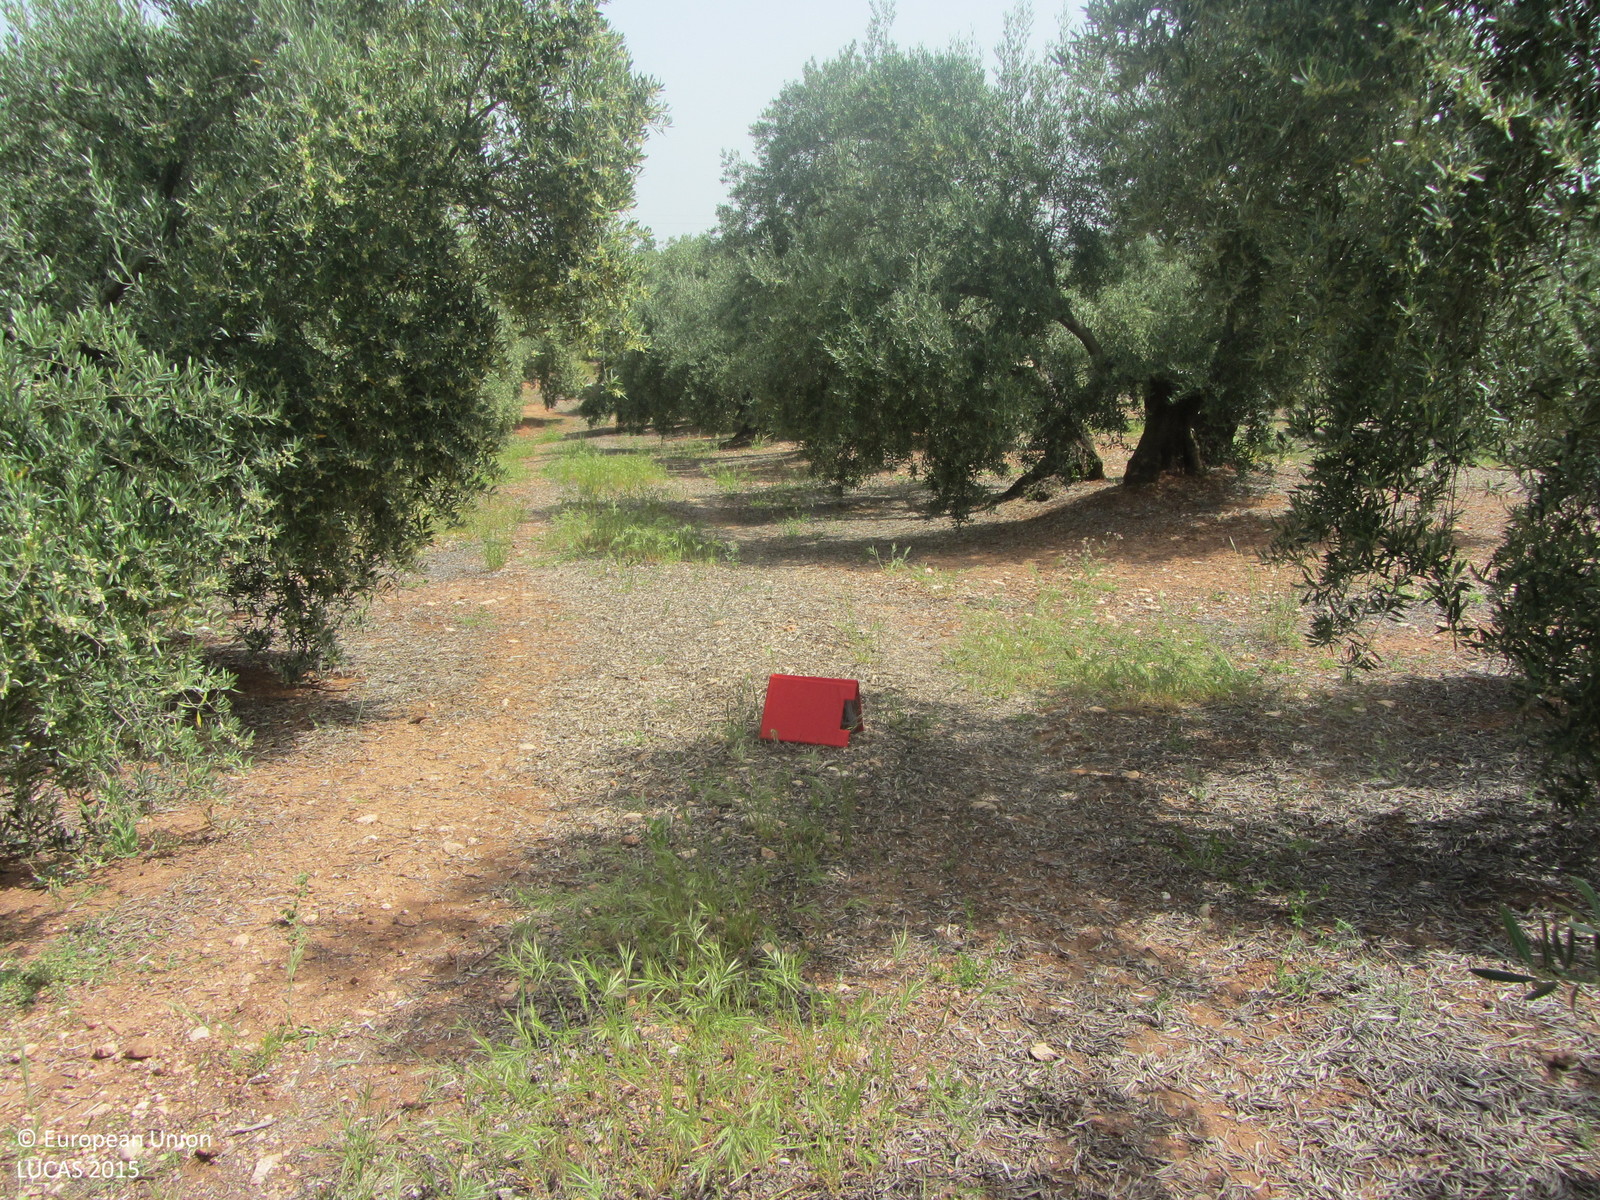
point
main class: Cropland
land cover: Olive groves
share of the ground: 50 - 75 %
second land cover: Spontaneously vegetated surfaces
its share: 10 - 25 %
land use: Agriculture (excluding fallow land and kitchen gardens)
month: May
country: ES
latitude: 38.2937
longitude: -2.9085
